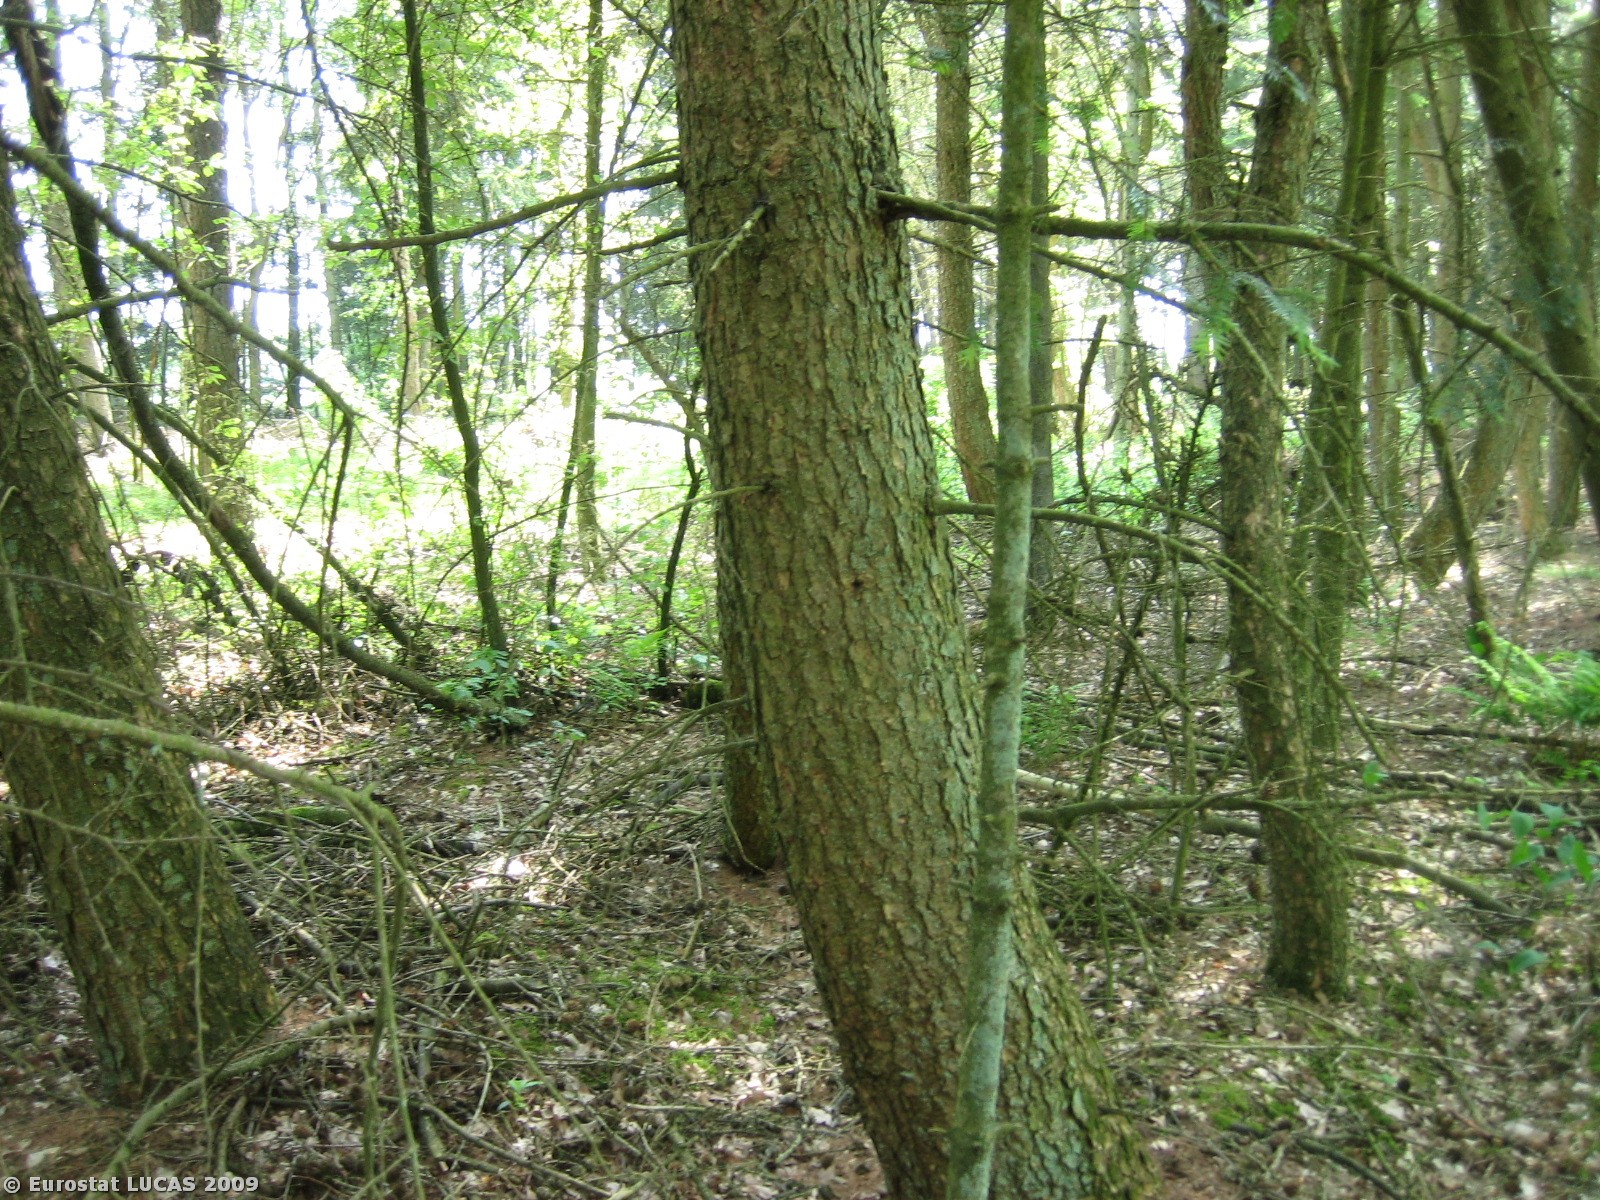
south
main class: Woodland
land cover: Mixed woodland
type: mesophytic deciduous forest
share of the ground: > 75 %
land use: Forestry
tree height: > 5 m
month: May
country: DK
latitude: 56.0954
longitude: 9.2133
